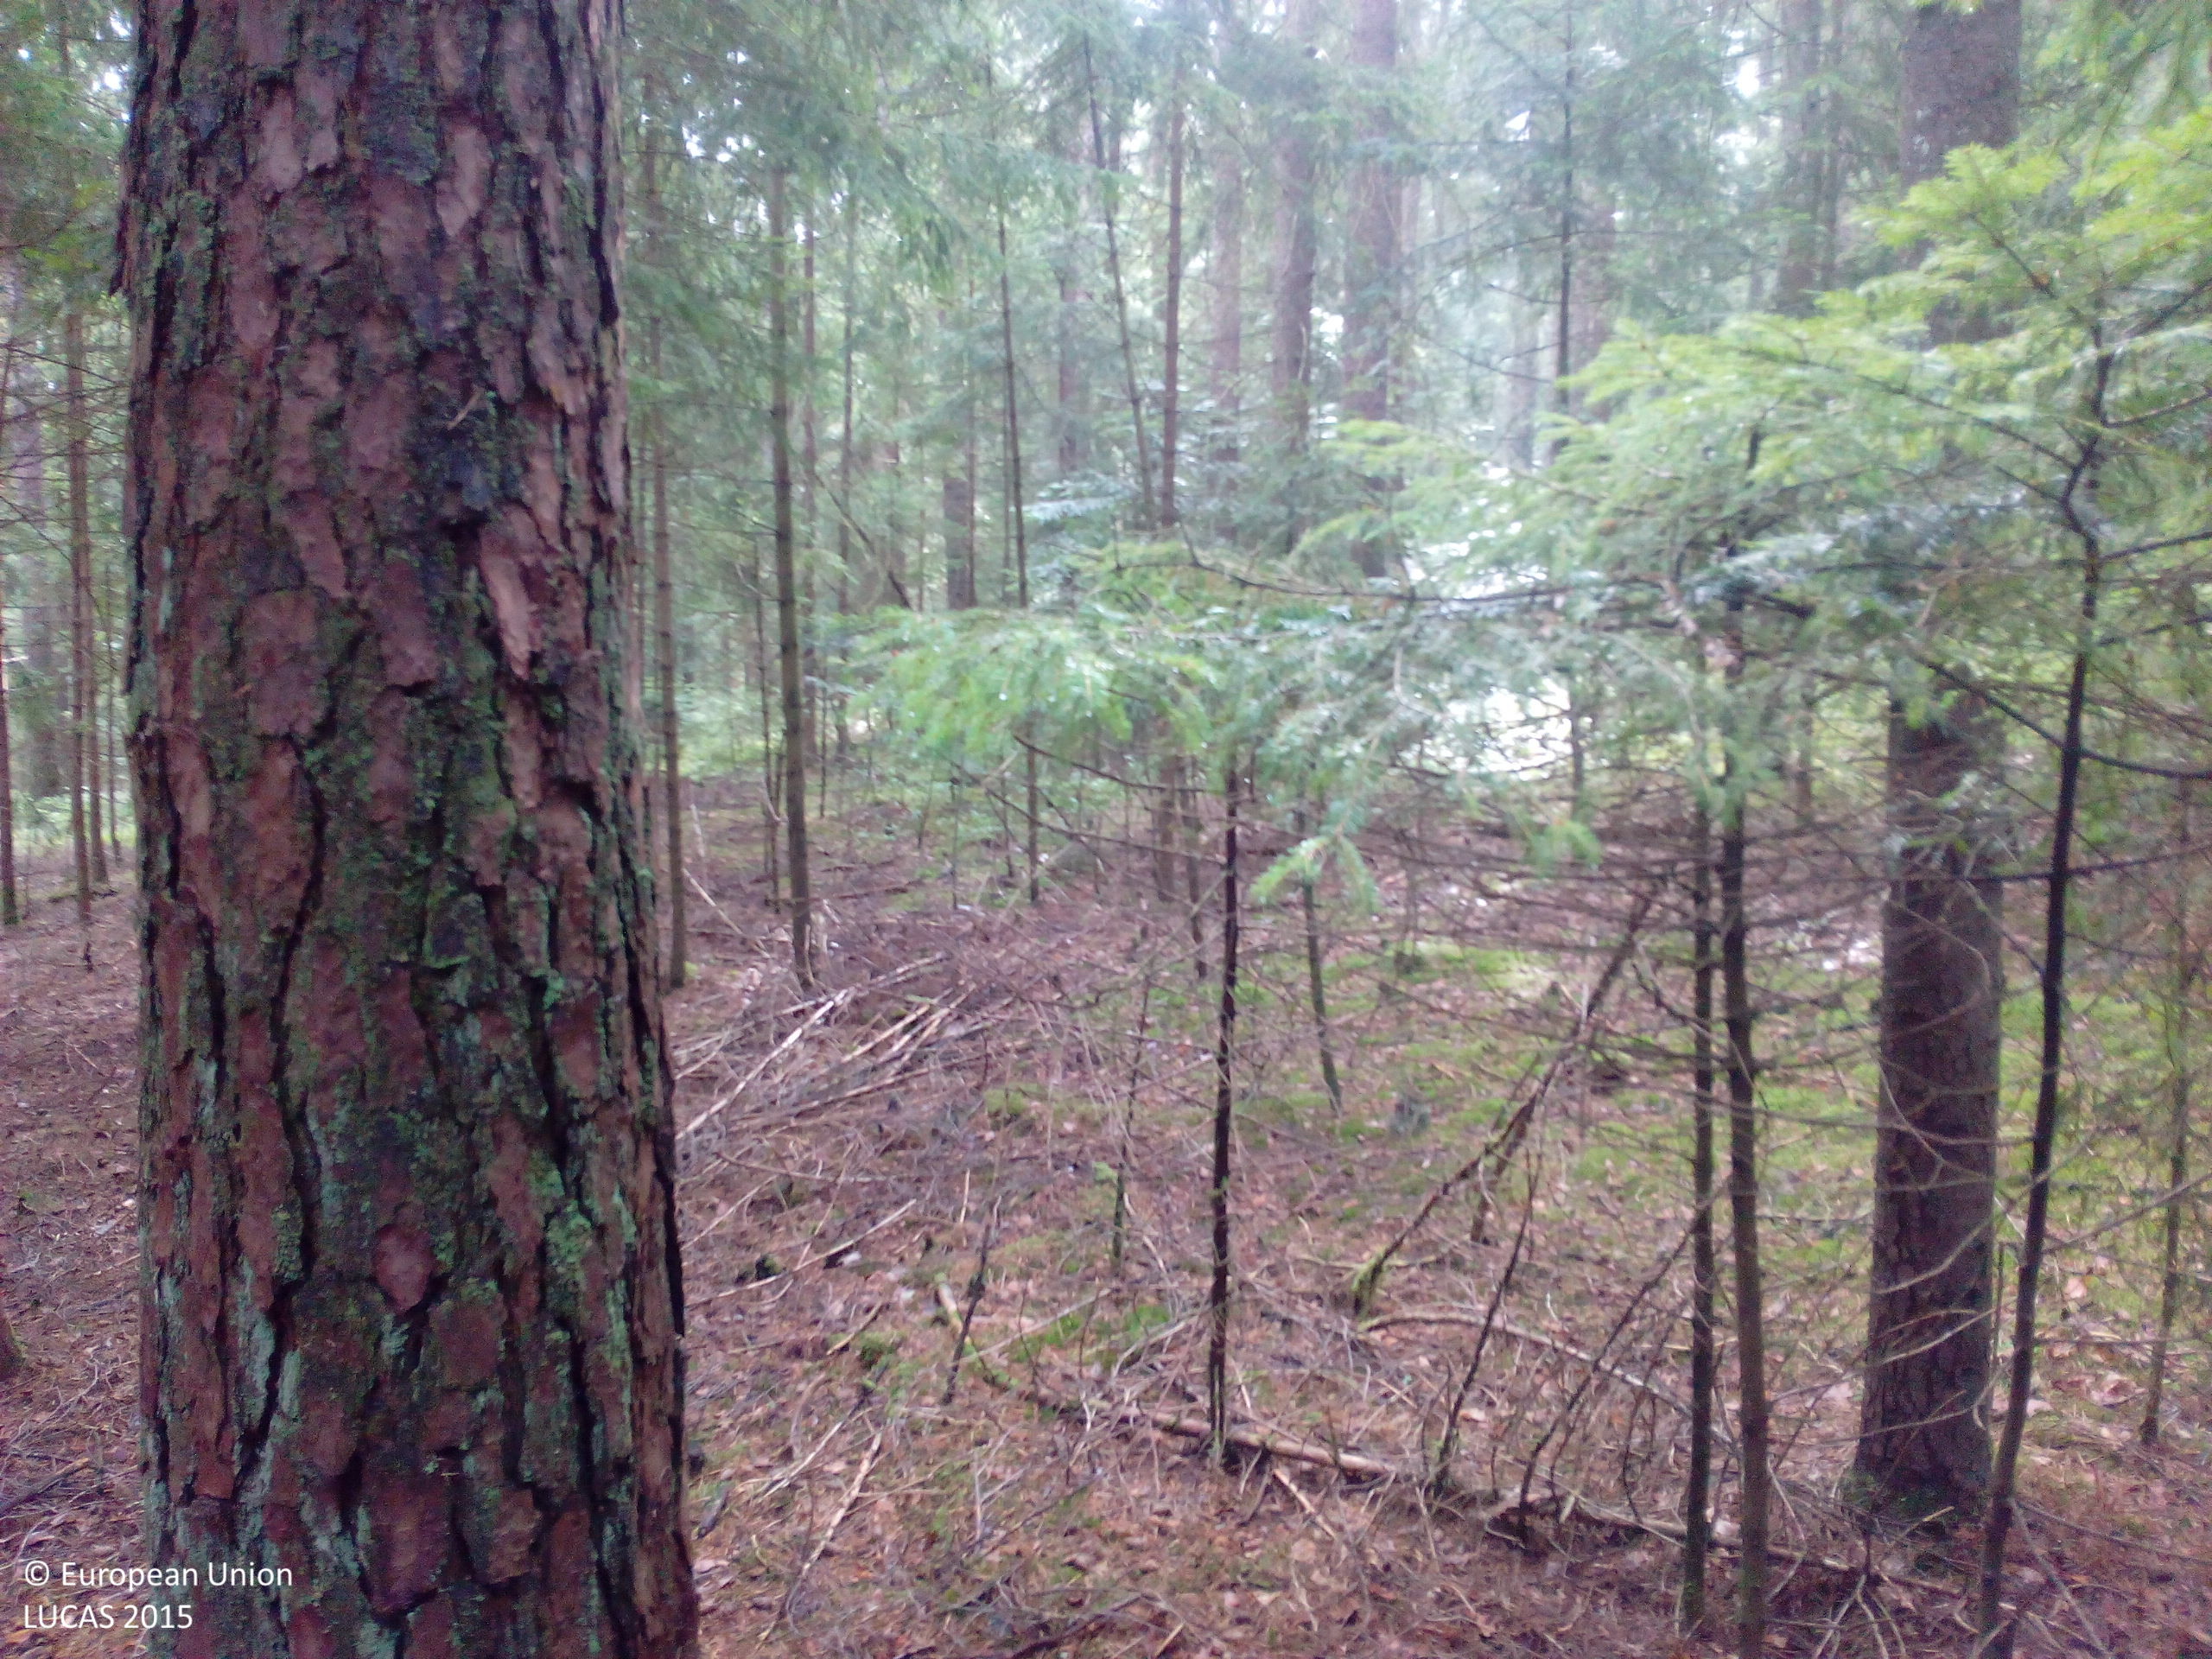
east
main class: Woodland
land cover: Other coniferous woodland
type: hemiboreal forest and nemoral coniferous forest and mixed broadleaved-coniferous forest
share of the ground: 50 - 75 %
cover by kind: coniferous forest trees 70 %, lichens and mosses 20 %, unconsolidated bare surface 10 %
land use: Forestry
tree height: > 5 m
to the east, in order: Other coniferous woodland; Tracks; Spruce dominated mixed woodland; Tracks; Spruce dominated coniferous woodland; Tracks; Spruce dominated coniferous woodland
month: July
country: DE
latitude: 49.1204
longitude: 12.9455
